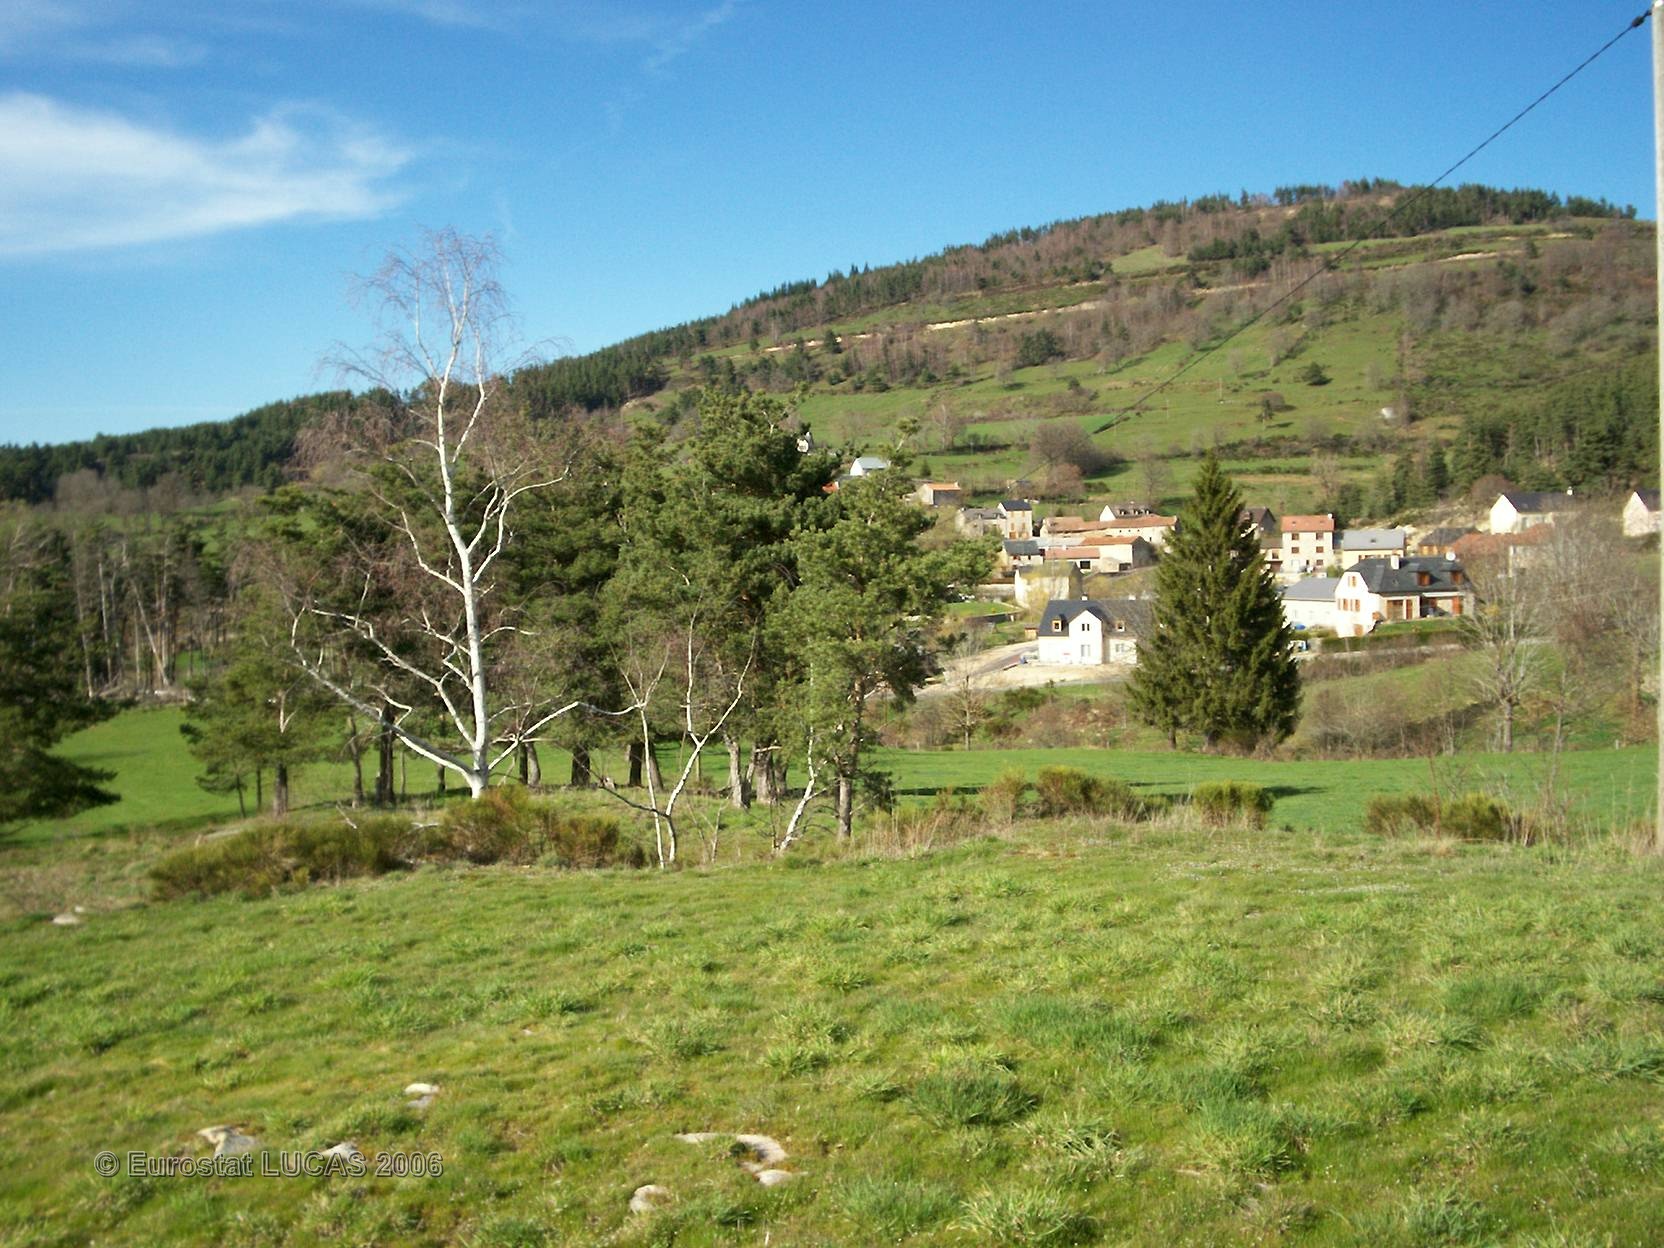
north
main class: Grassland
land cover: Grassland without tree/shrub cover
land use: Agriculture (excluding fallow land and kitchen gardens)
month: April
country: FR
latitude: 44.8434
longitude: 3.3617
